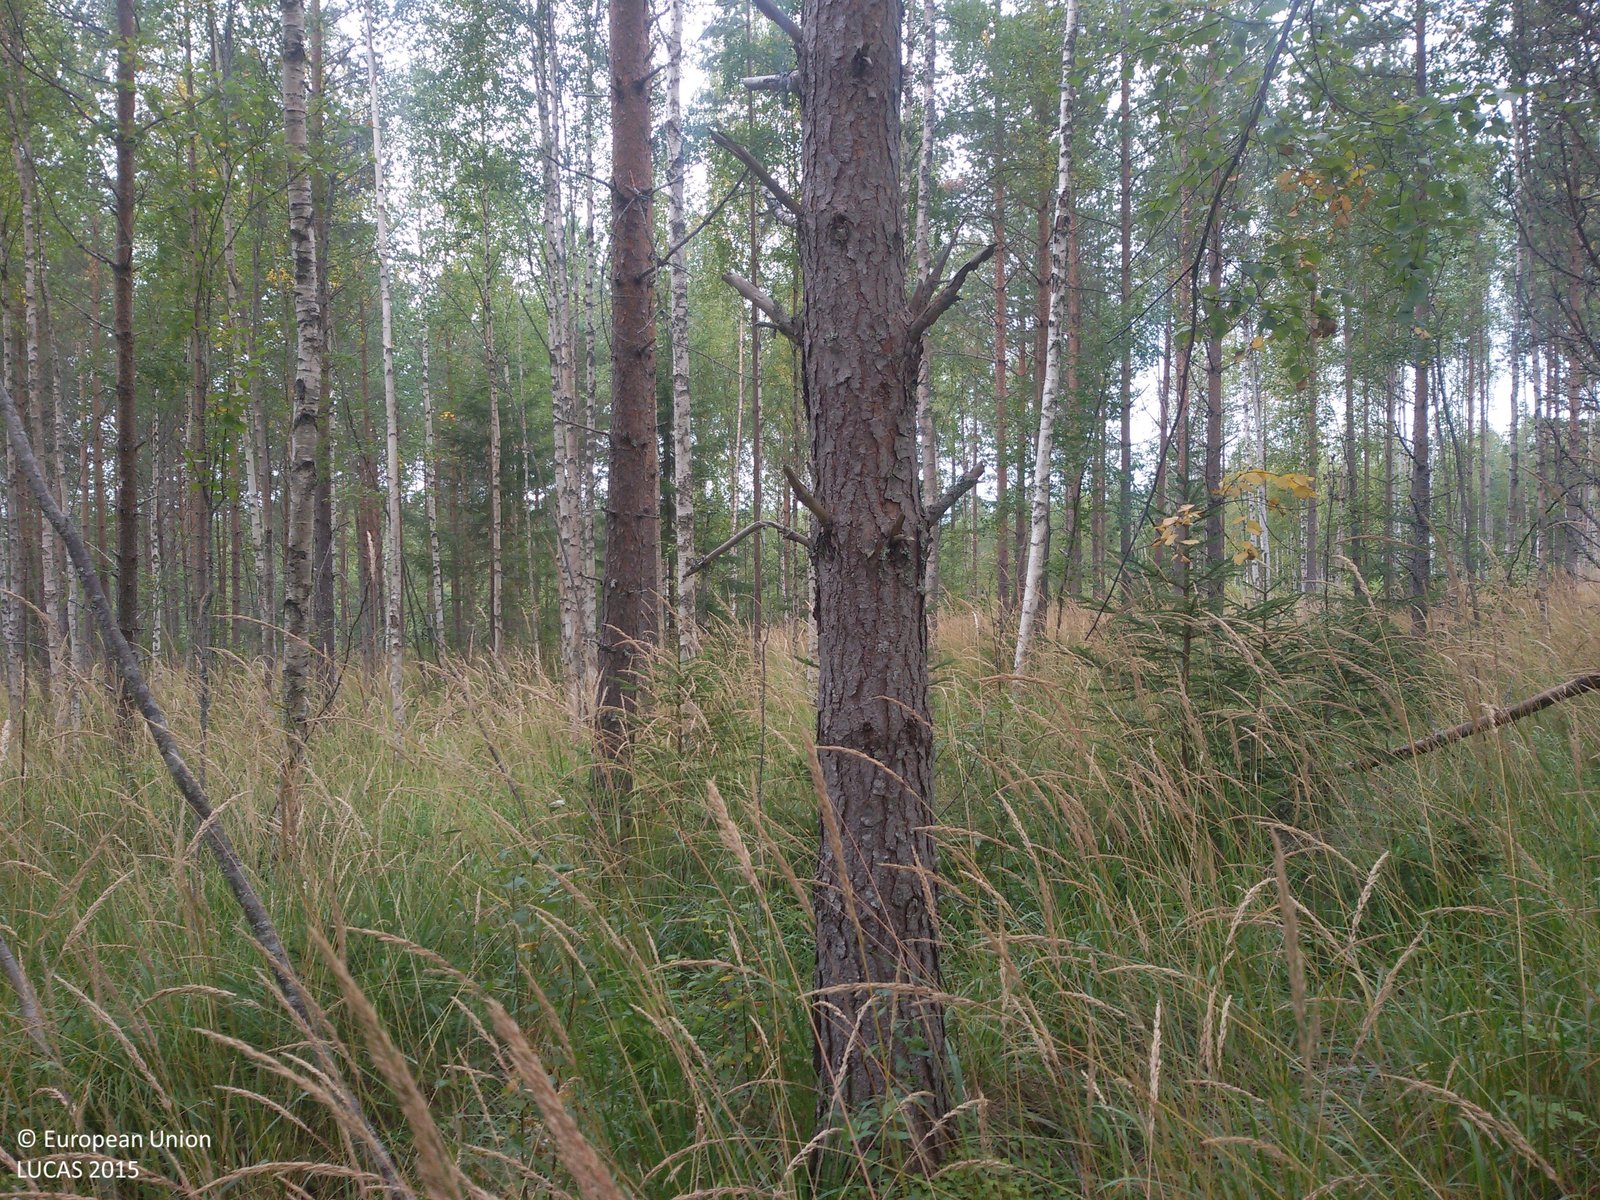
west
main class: Woodland
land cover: Pine dominated mixed woodland
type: boreal forest
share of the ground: > 75 %
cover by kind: coniferous forest trees 40 %, broadleaved forest trees 30 %, shrubs 25 %, lichens and mosses 5 %
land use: Forestry
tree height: > 5 m
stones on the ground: < 10 %
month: September
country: SE
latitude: 60.8597
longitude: 15.2332
